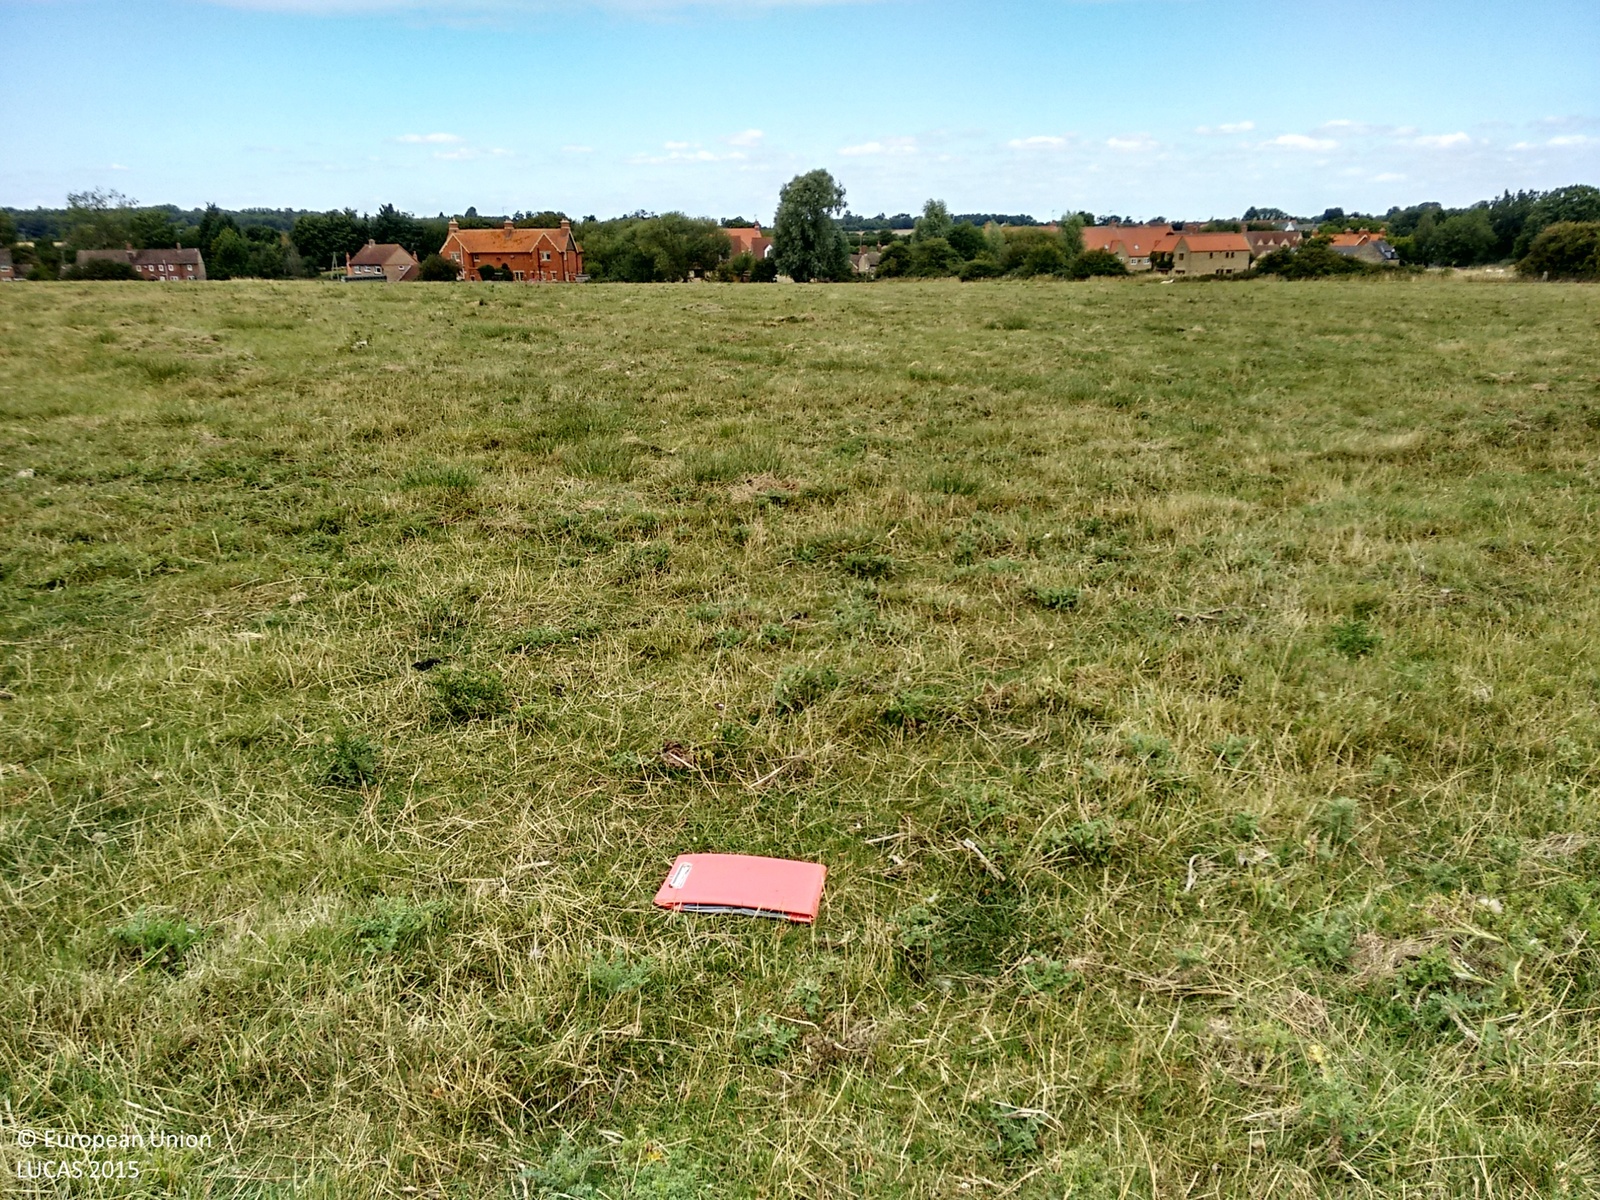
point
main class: Grassland
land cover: Grassland without tree/shrub cover
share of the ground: > 75 %
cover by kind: herbaceous plants 100 %
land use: Agriculture (excluding fallow land and kitchen gardens)
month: August
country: GB
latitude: 52.1975
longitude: -0.7359
